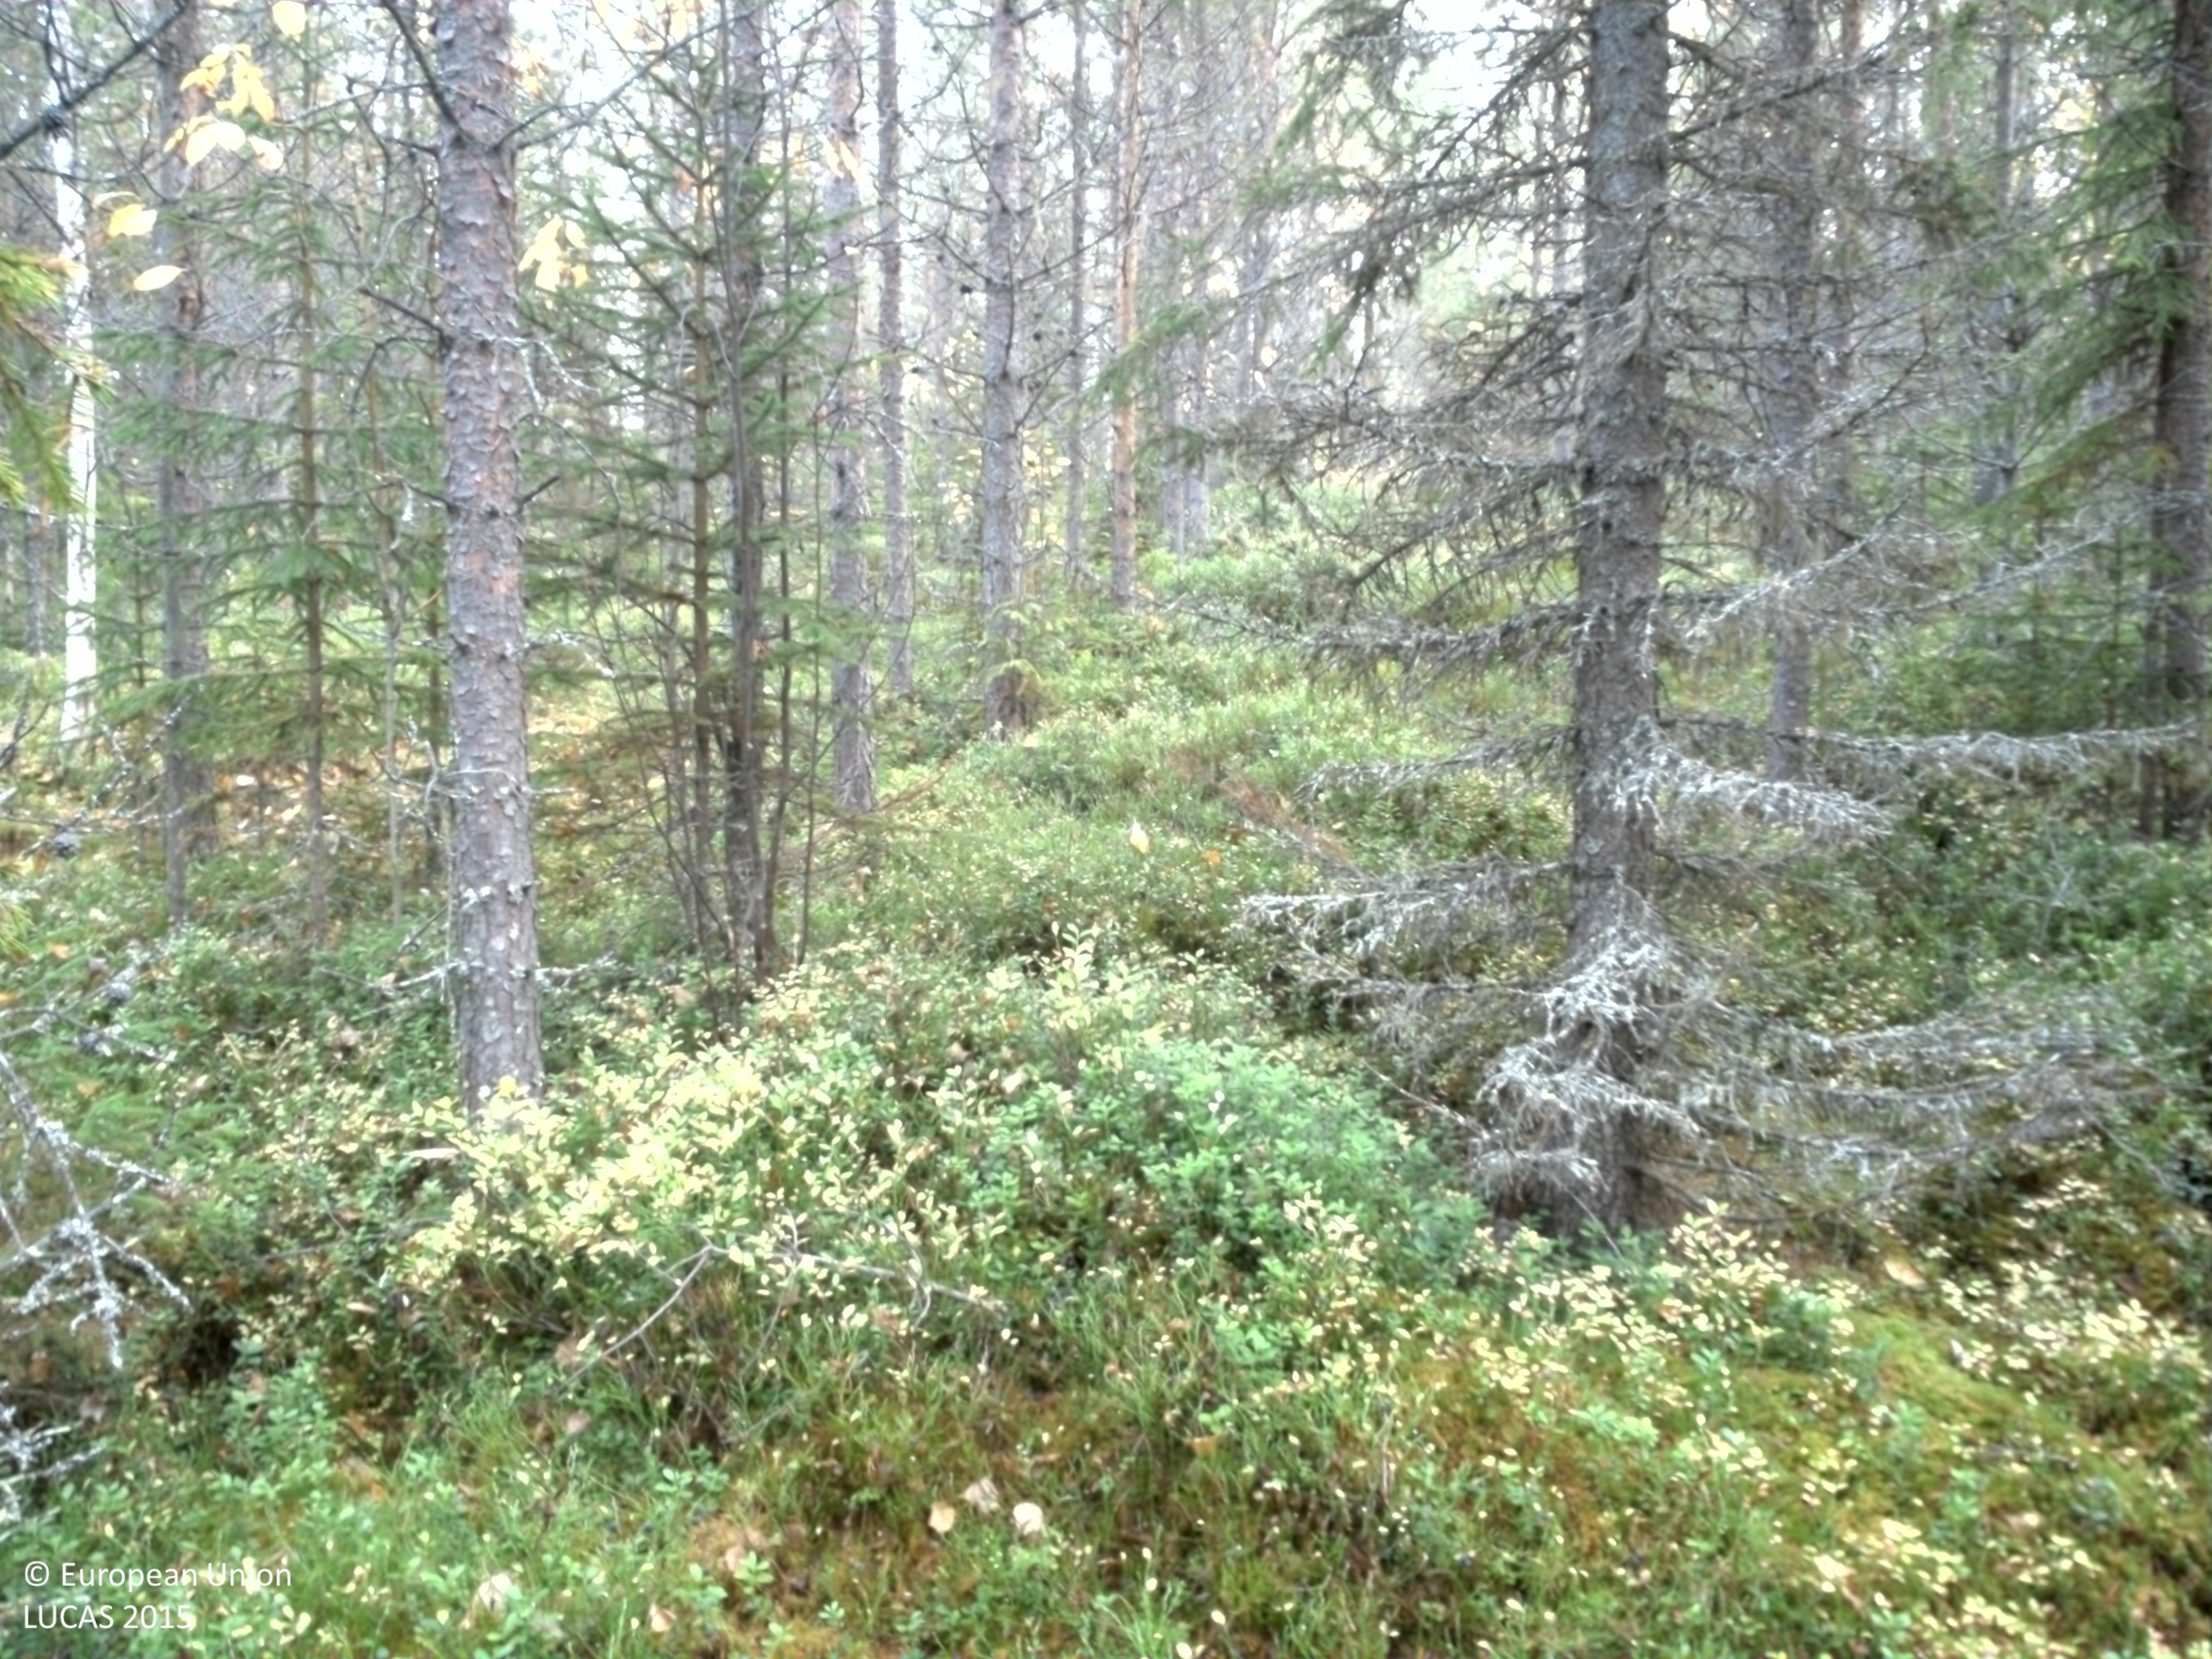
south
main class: Woodland
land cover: Pine dominated coniferous woodland
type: boreal forest
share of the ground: 25 - 50 %
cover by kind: shrubs 45 %, coniferous forest trees 35 %, lichens and mosses 15 %, broadleaved forest trees 5 %
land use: Forestry
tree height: > 5 m
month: September
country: SE
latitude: 64.9143
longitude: 17.8068
